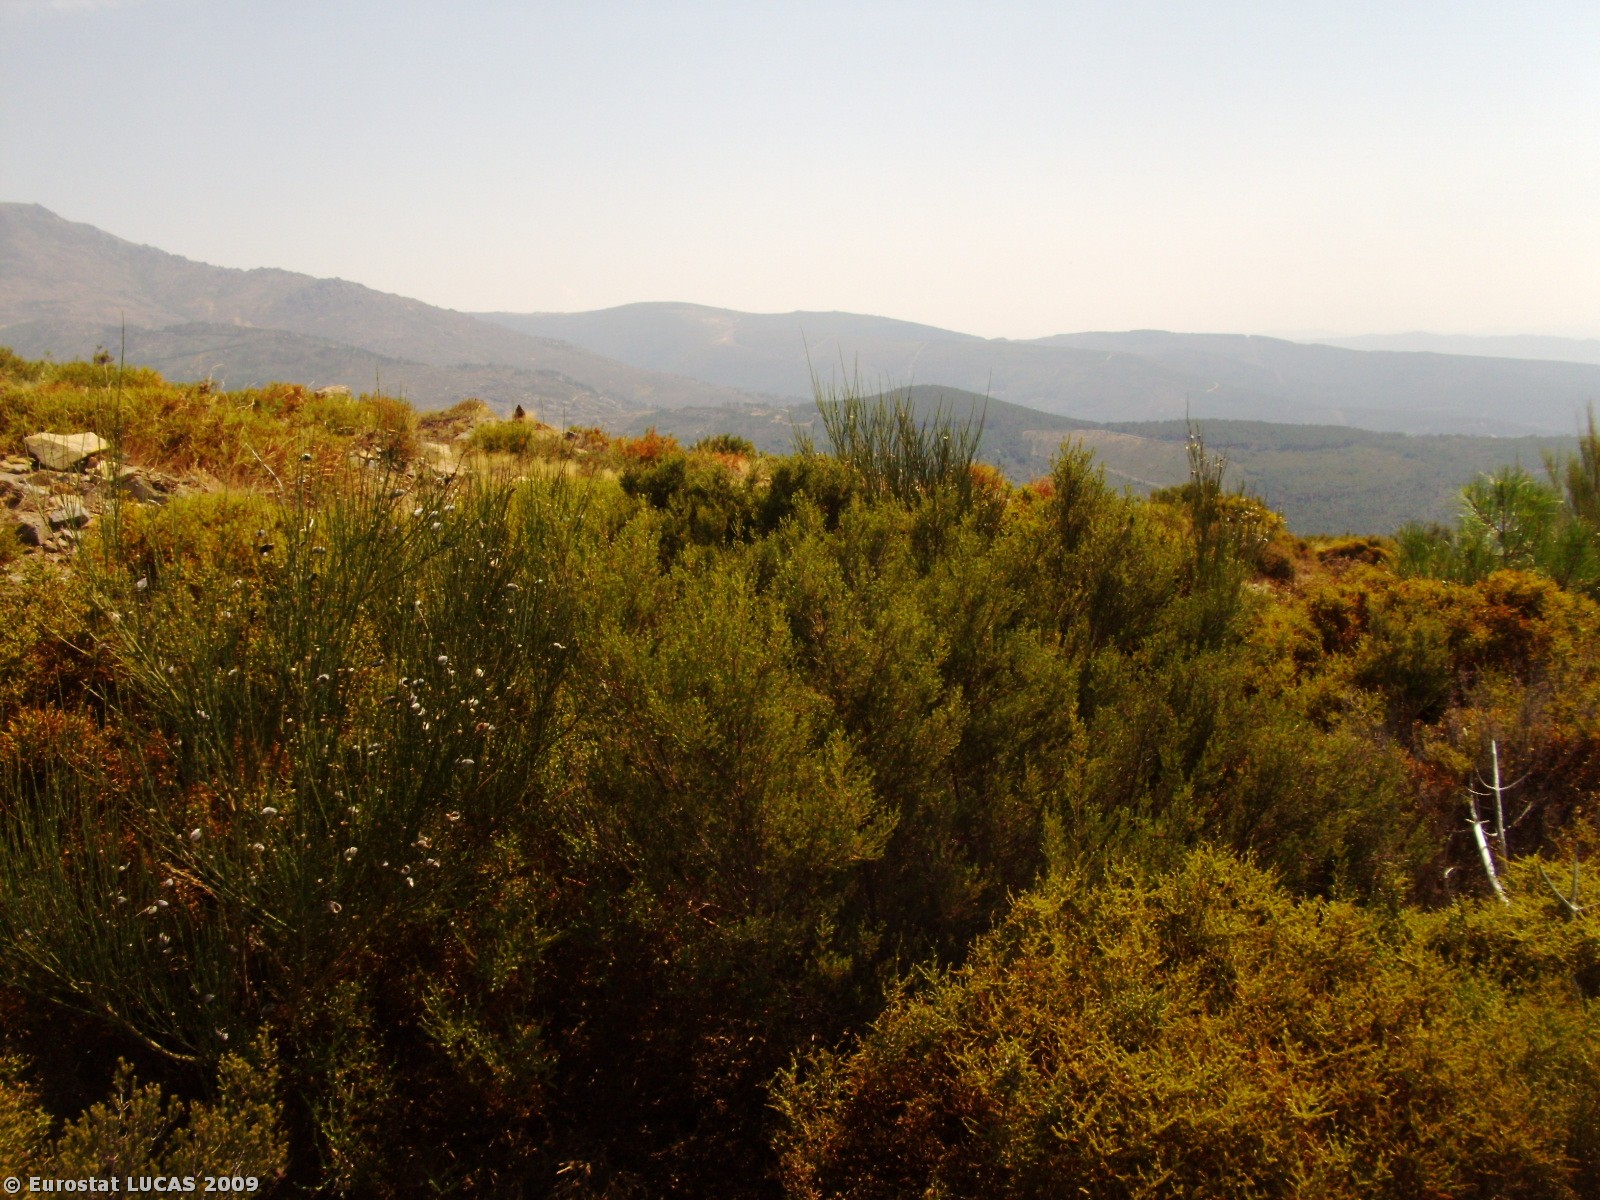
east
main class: Shrubland
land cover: Shrubland without tree cover
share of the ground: > 75 %
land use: Forestry
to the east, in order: Shrubland without tree cover; Tracks; Shrubland without tree cover; Tracks; Shrubland without tree cover
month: August
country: PT
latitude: 40.2607
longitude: -7.6418
